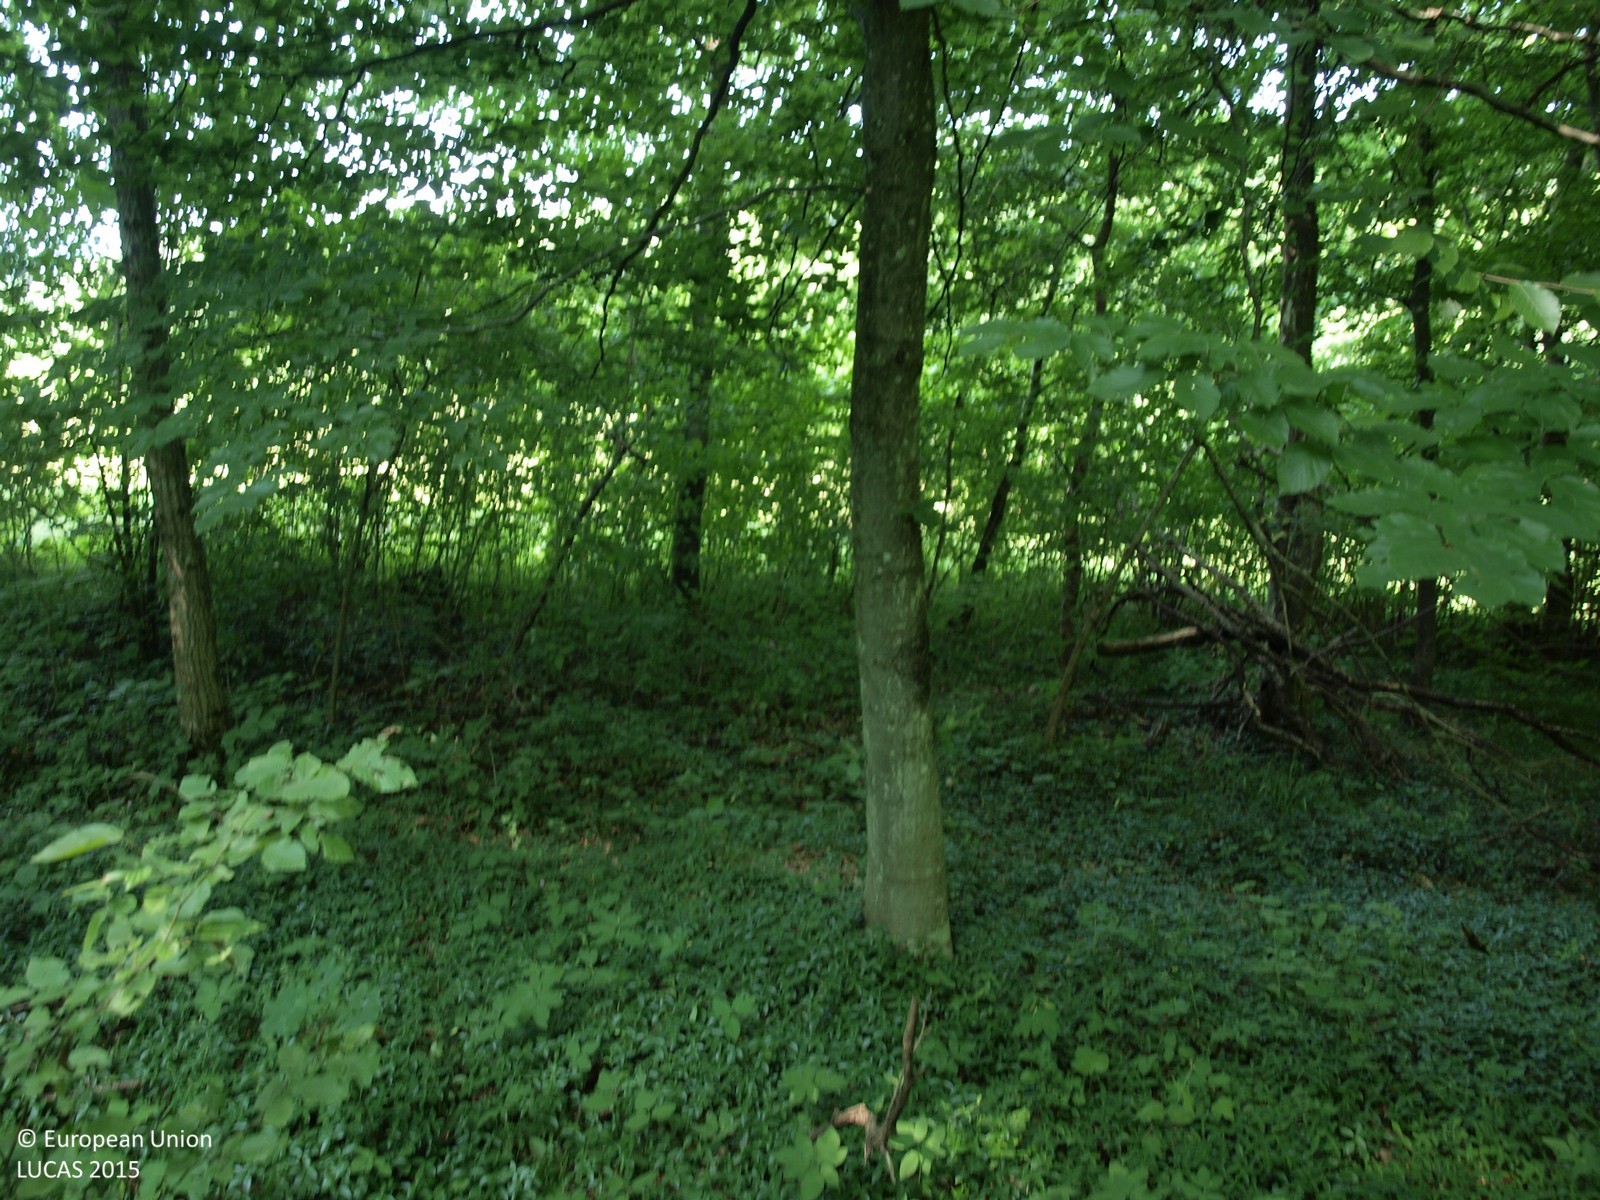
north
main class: Woodland
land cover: Broadleaved woodland
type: beech forest
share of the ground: > 75 %
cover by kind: broadleaved forest trees 100 %
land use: Forestry
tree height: > 5 m
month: July
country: HR
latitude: 46.1291
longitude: 15.9912
